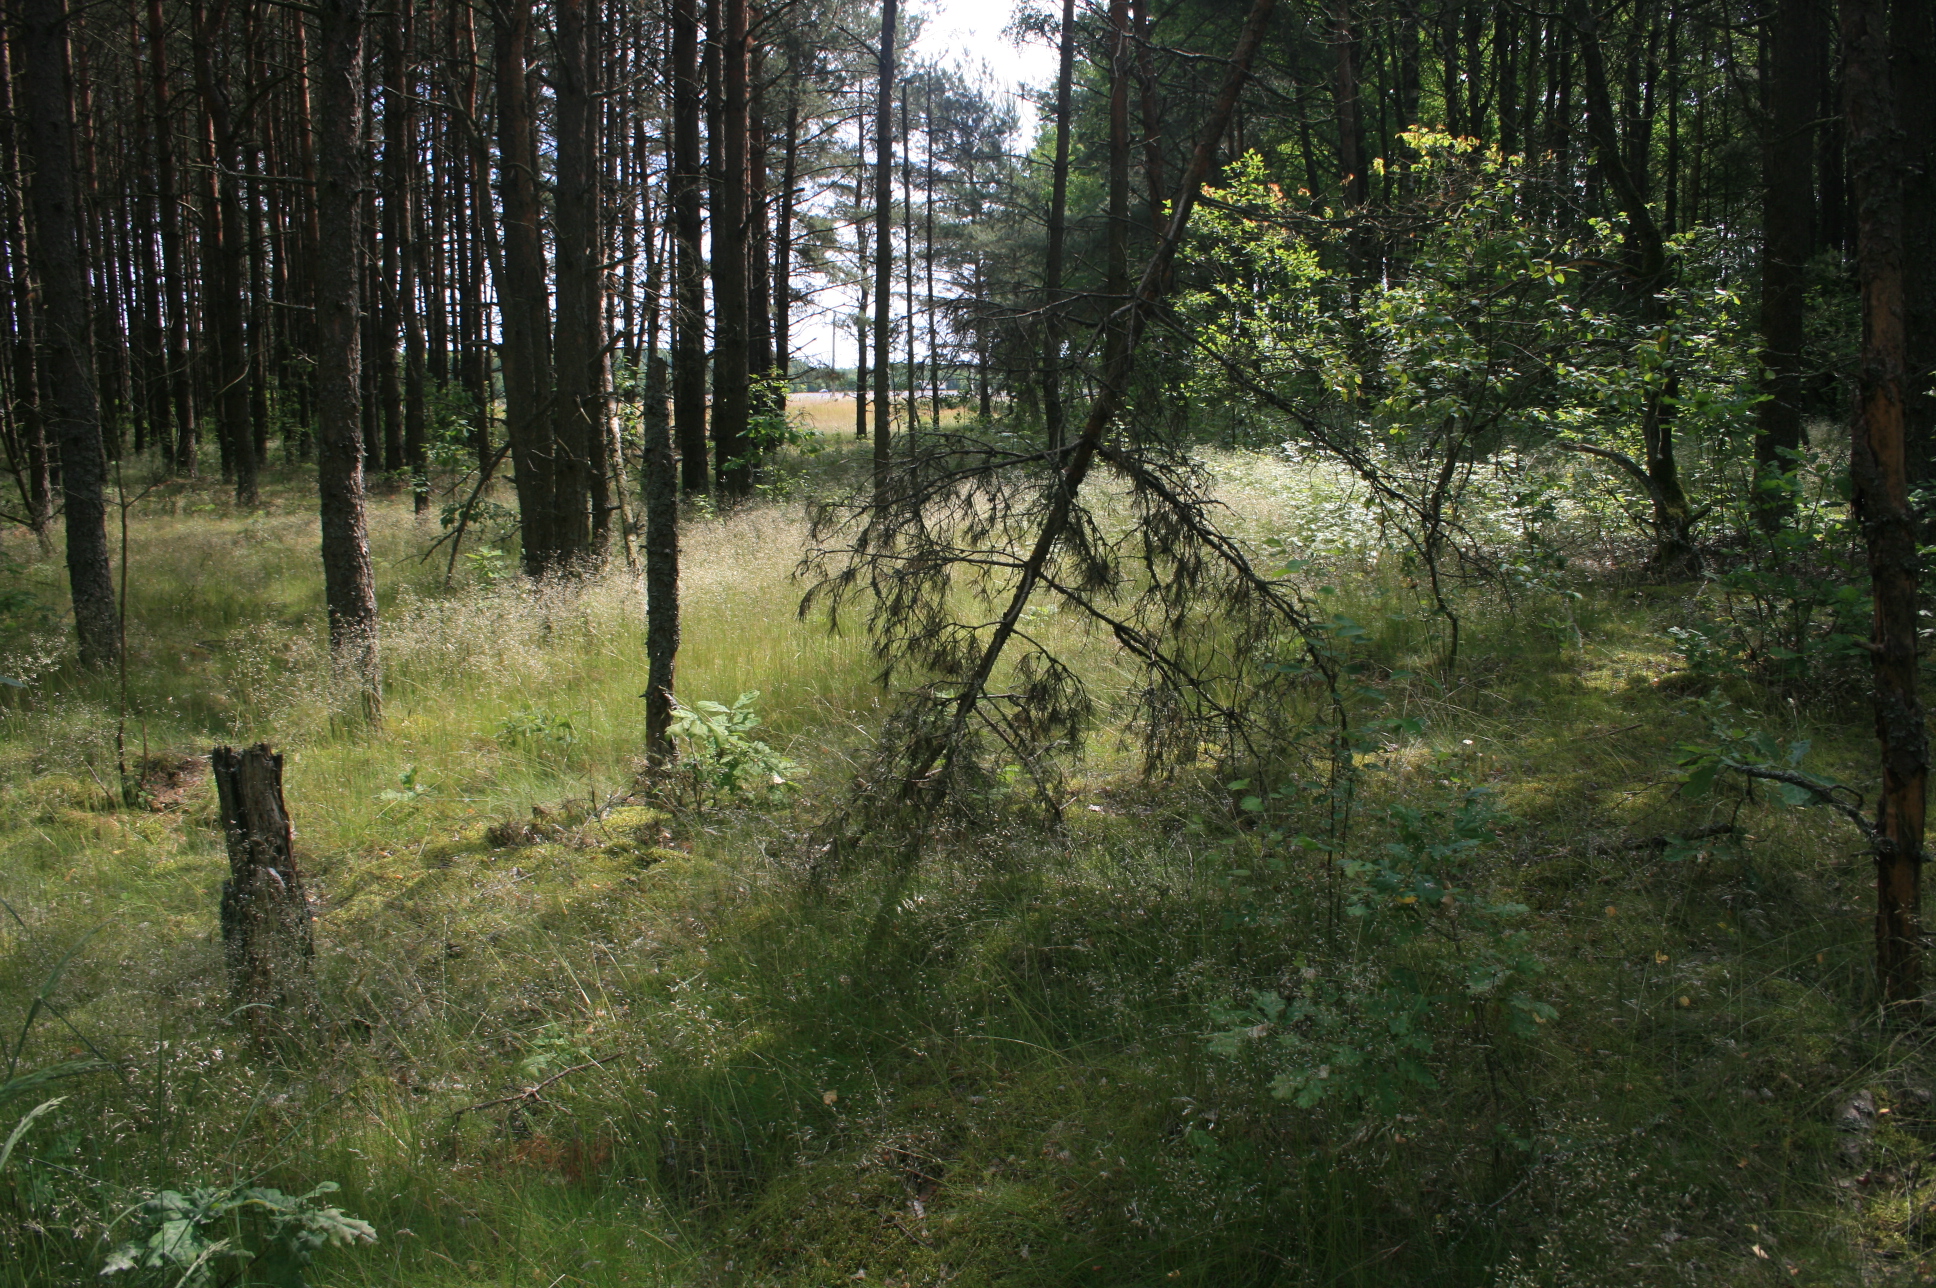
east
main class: Woodland
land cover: Pine dominated mixed woodland
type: hemiboreal forest and nemoral coniferous forest and mixed broadleaved-coniferous forest
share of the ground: > 75 %
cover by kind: coniferous forest trees 55 %, broadleaved forest trees 30 %, herbaceous plants 15 %
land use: Forestry
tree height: > 5 m
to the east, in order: Pine dominated mixed woodland; Pine dominated coniferous woodland; Tracks; Pine dominated coniferous woodland; Grassland without tree/shrub cover; Electric lines; Grass margins; Tracks; Grassland without tree/shrub cover; Electric lines; Spontaneously vegetated surfaces; Electric lines; Spontaneously vegetated surfaces
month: June
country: LT
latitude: 55.2114
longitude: 21.7267
